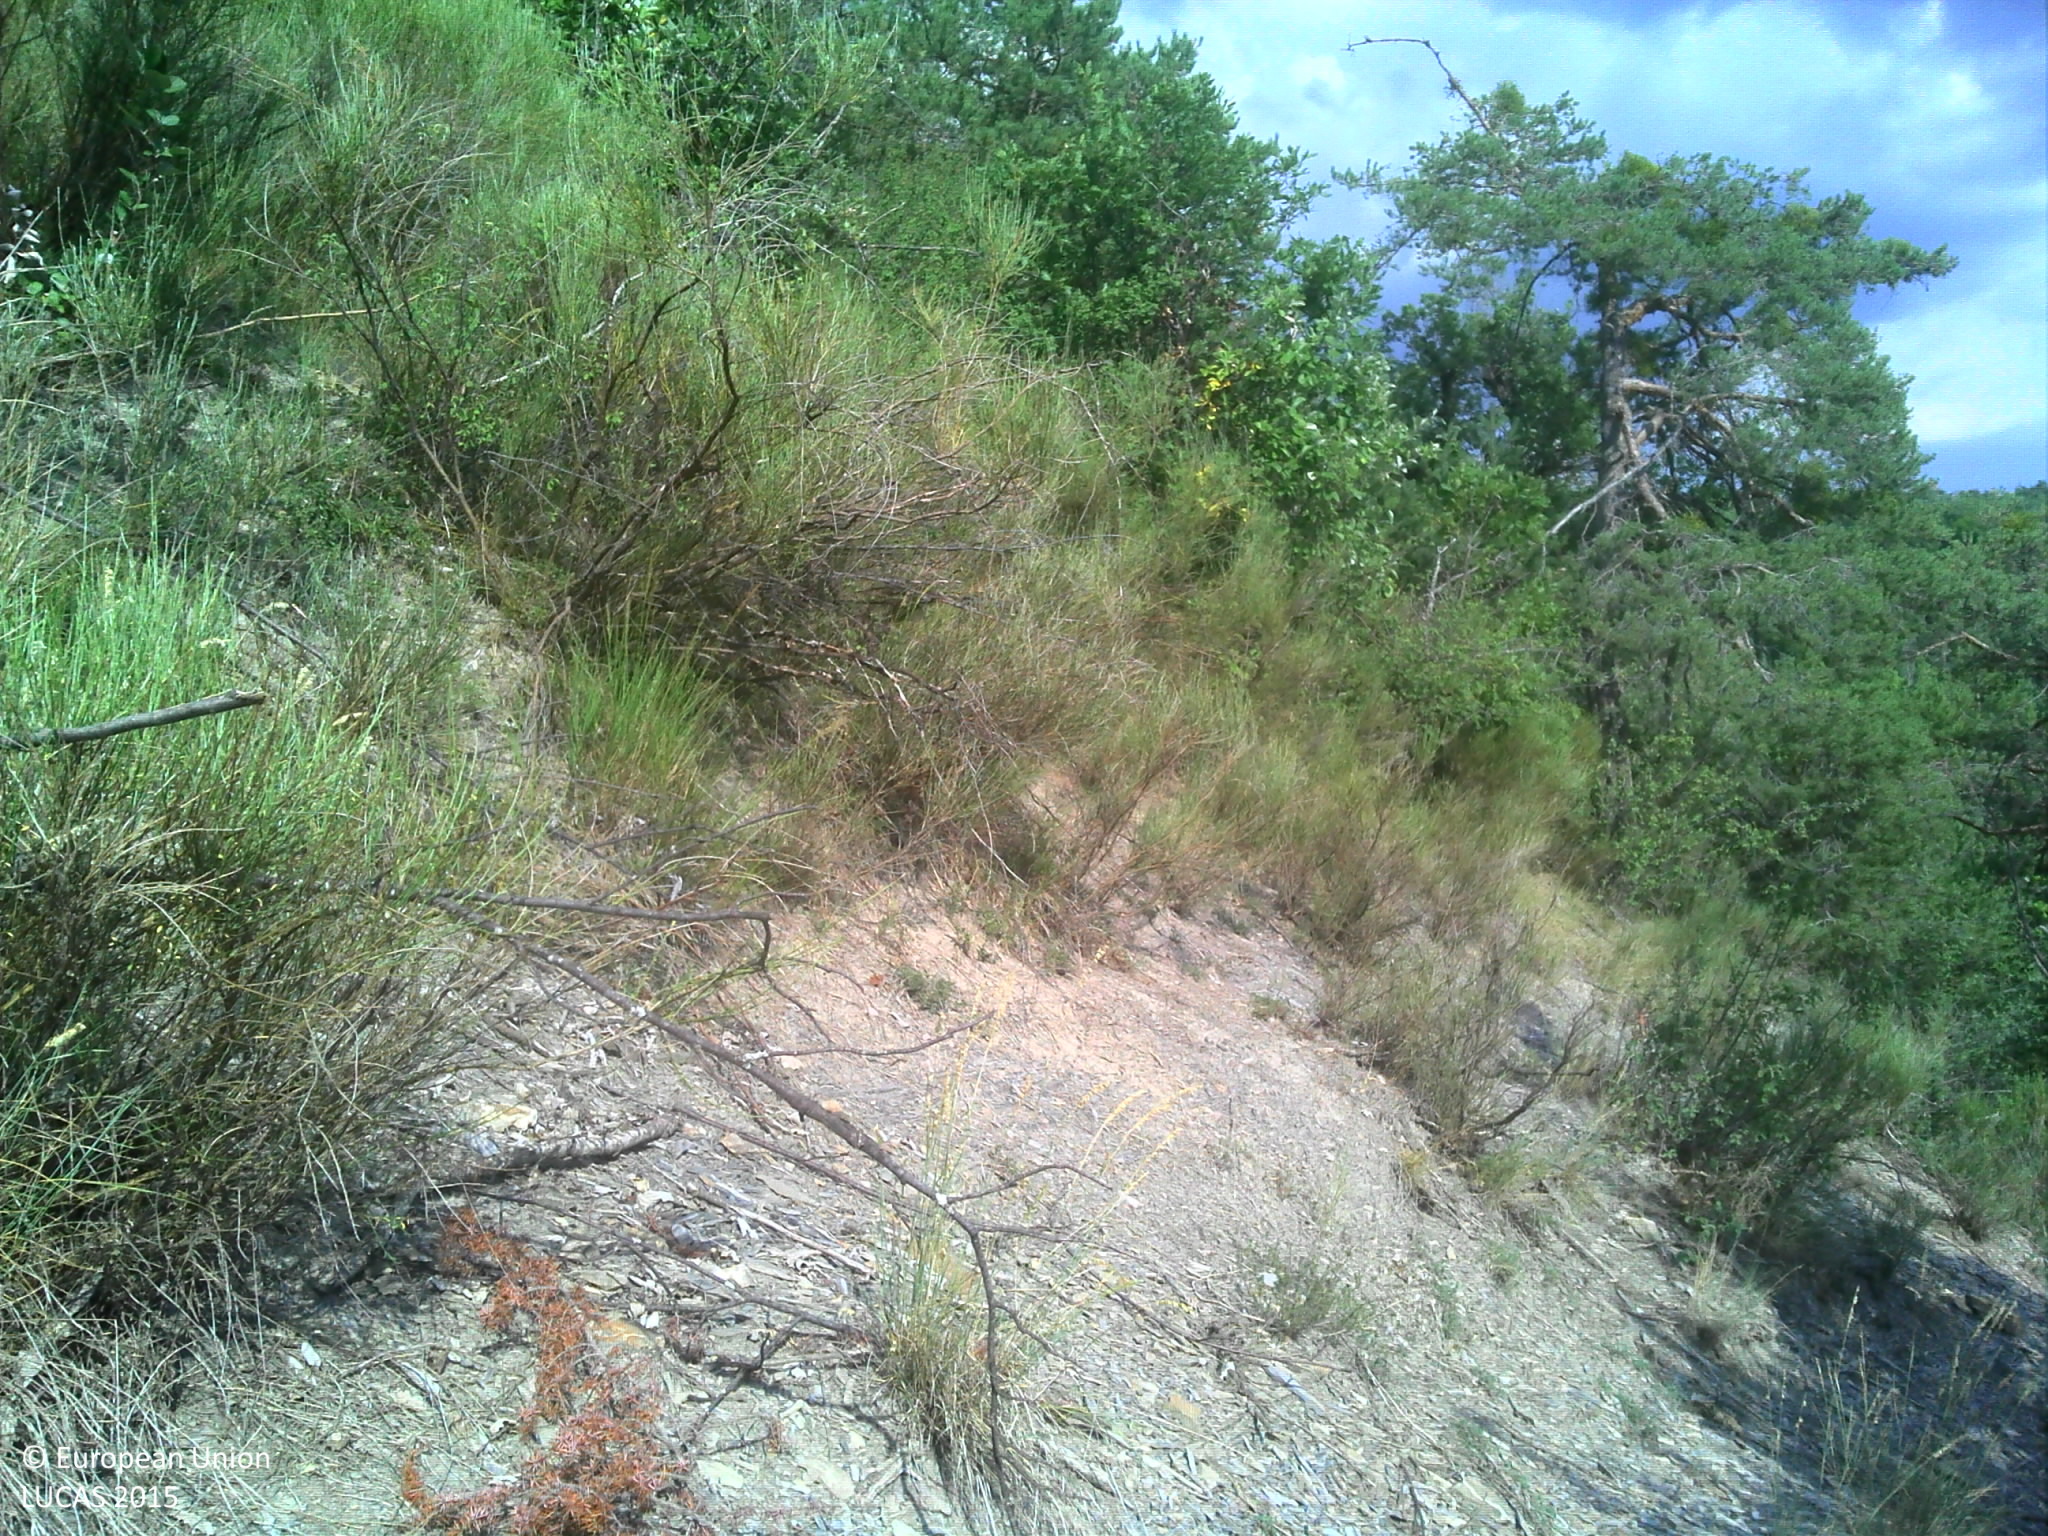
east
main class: Shrubland
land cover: Shrubland with sparse tree cover
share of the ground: 50 - 75 %
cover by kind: shrubs 50 %, herbaceous plants 20 %, consolidated bare surface 15 %, unconsolidated bare surface 10 %, broadleaved forest trees 5 %
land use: Semi-natural and natural areas not in use
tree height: < 5 m
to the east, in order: Shrubland with sparse tree cover; Rocks and stones; Shrubland with sparse tree cover; Pine dominated mixed woodland; Rocks and stones
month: August
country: FR
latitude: 44.3922
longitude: 6.2783
